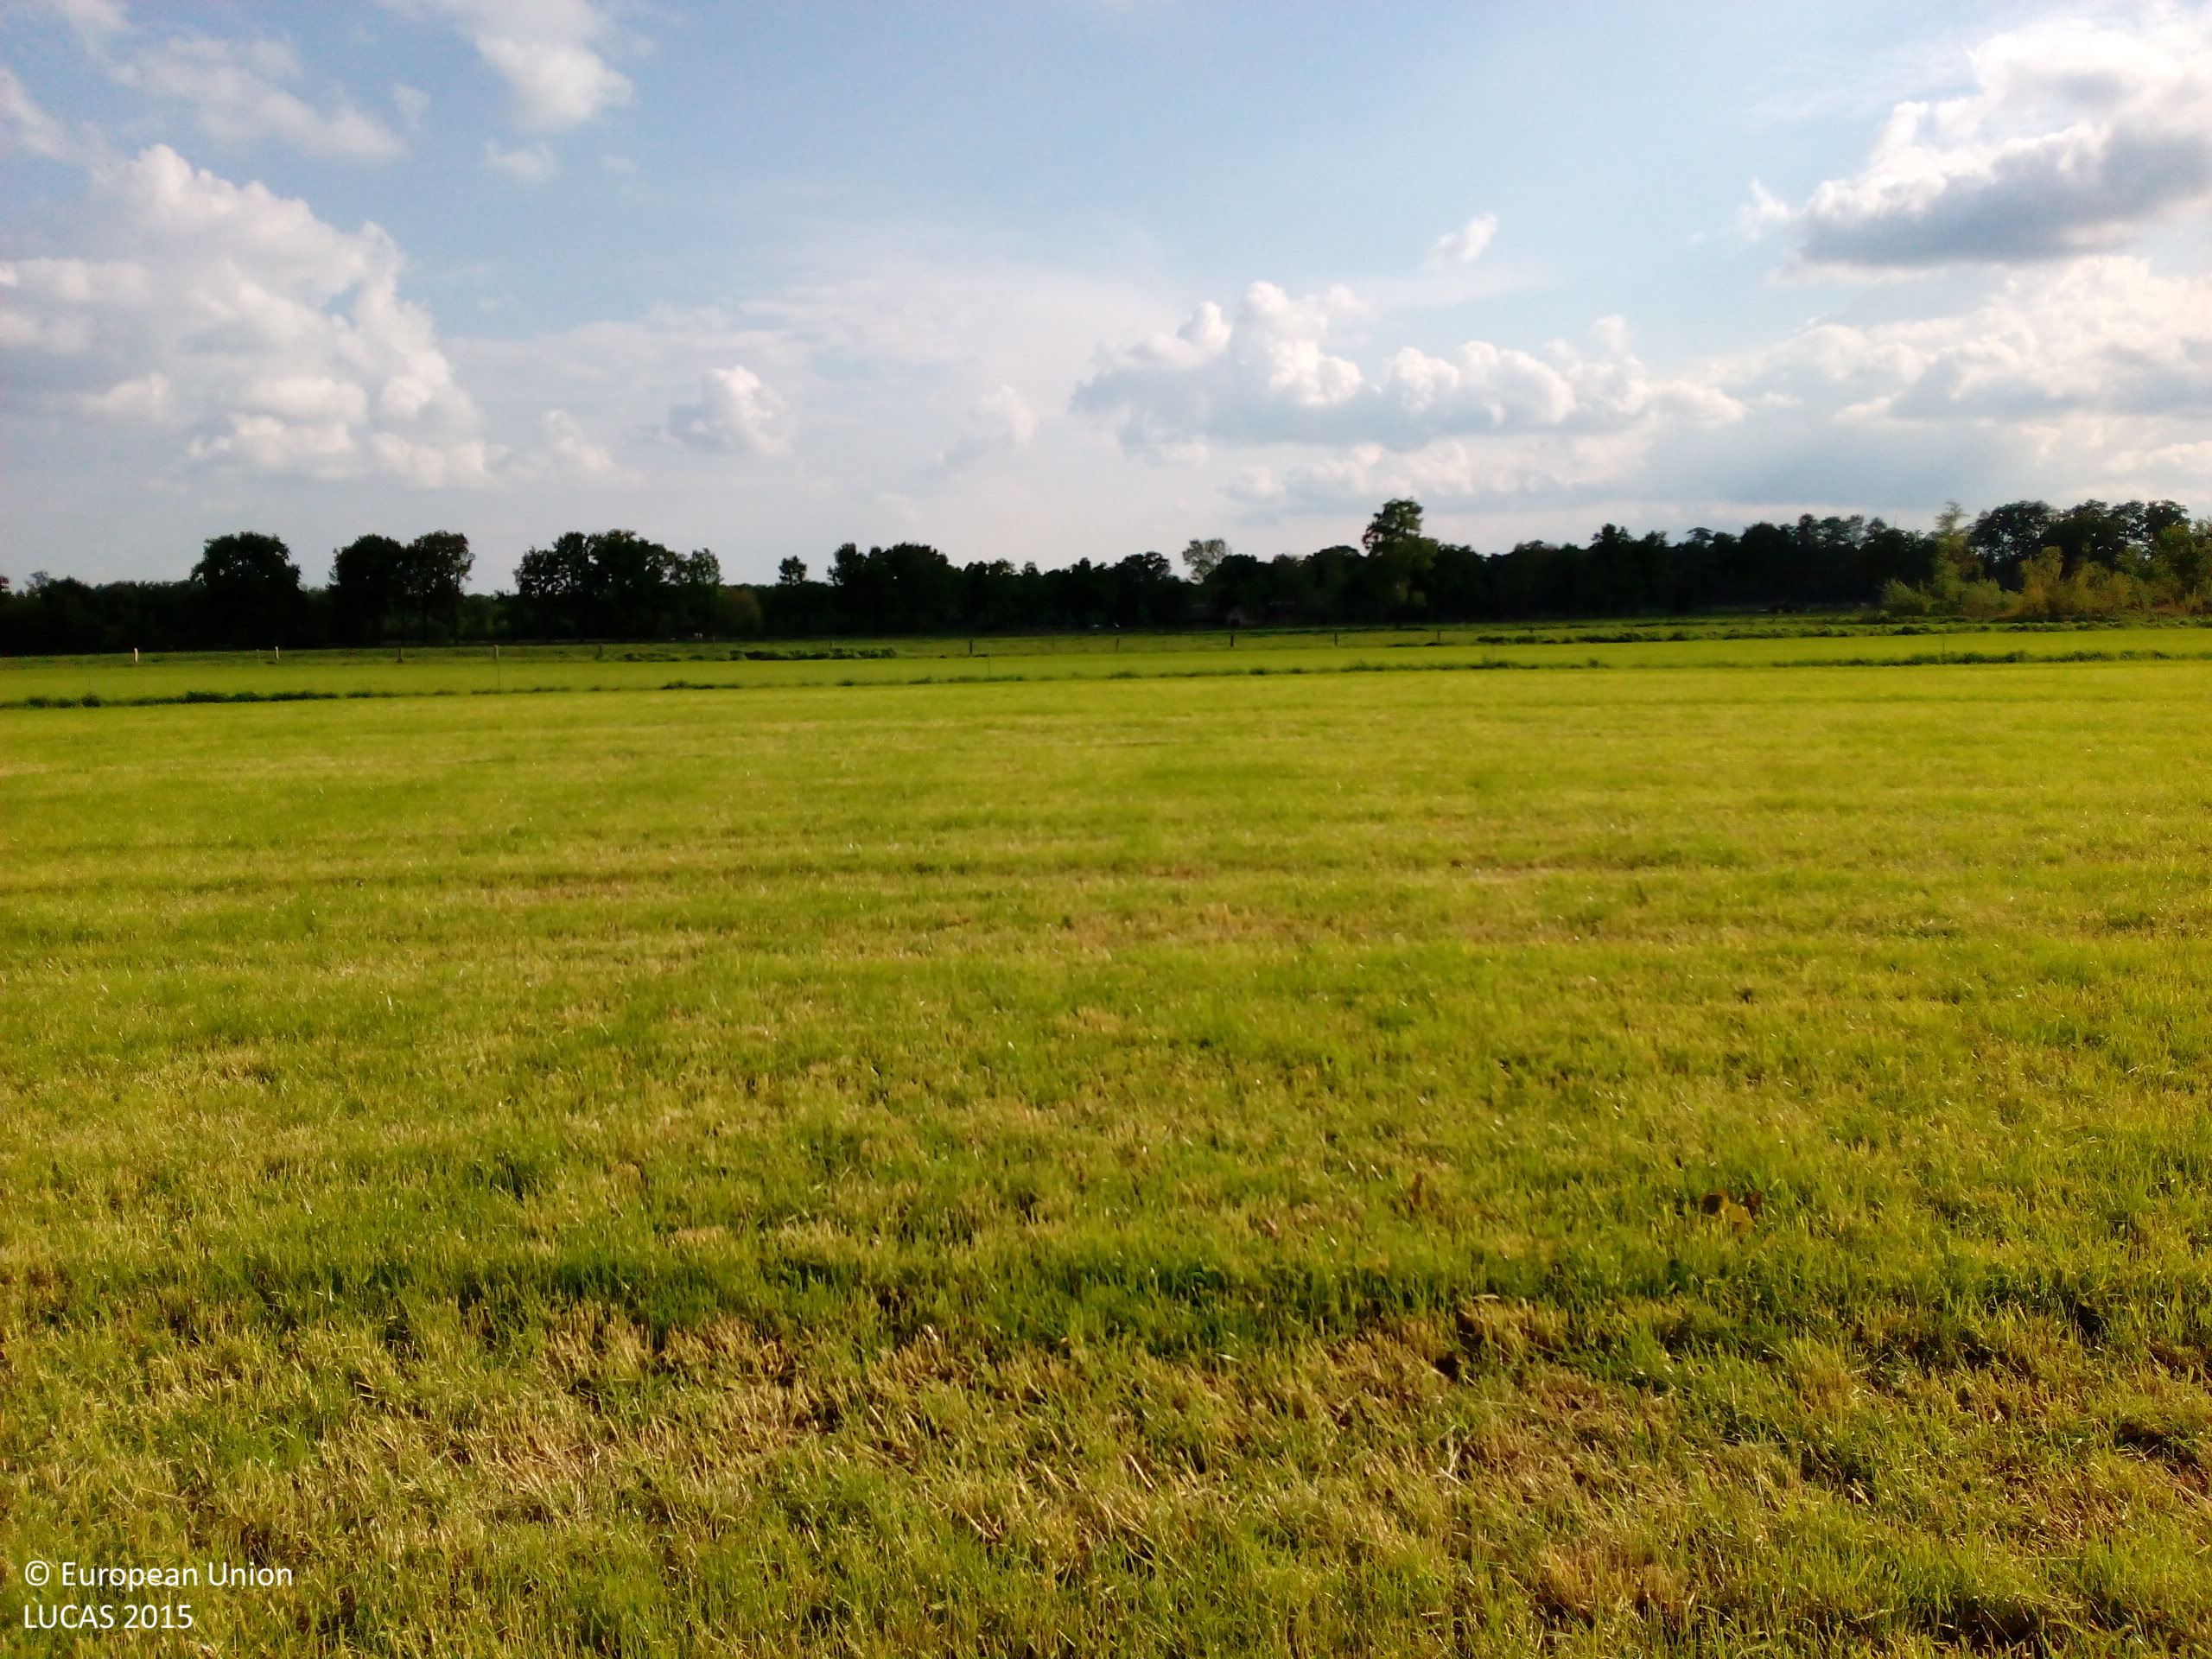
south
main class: Grassland
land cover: Grassland without tree/shrub cover
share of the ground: > 75 %
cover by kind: herbaceous plants 100 %
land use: Agriculture (excluding fallow land and kitchen gardens)
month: May
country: DE
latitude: 52.1881
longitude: 7.4405
